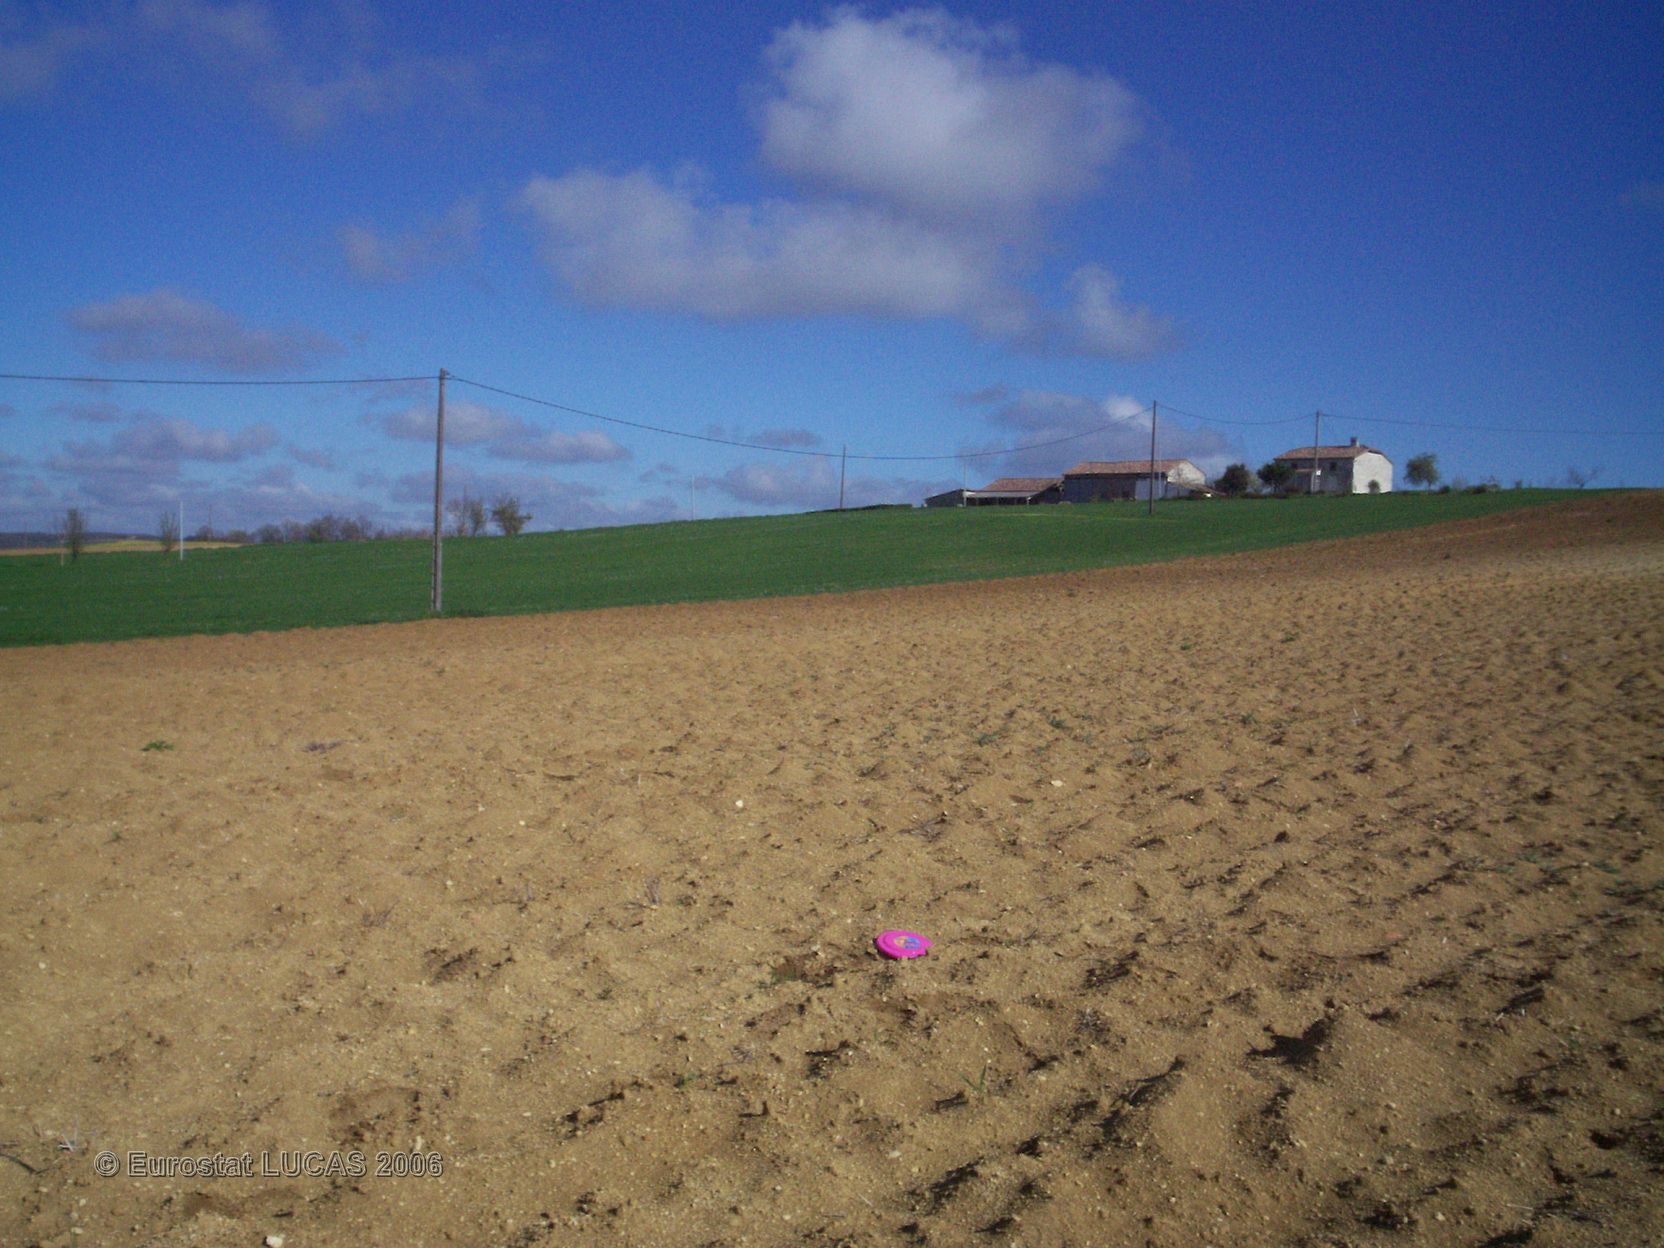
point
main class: Cropland
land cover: Sunflower
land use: Agriculture (excluding fallow land and kitchen gardens)
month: June
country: FR
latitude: 44.1838
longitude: 0.8769
